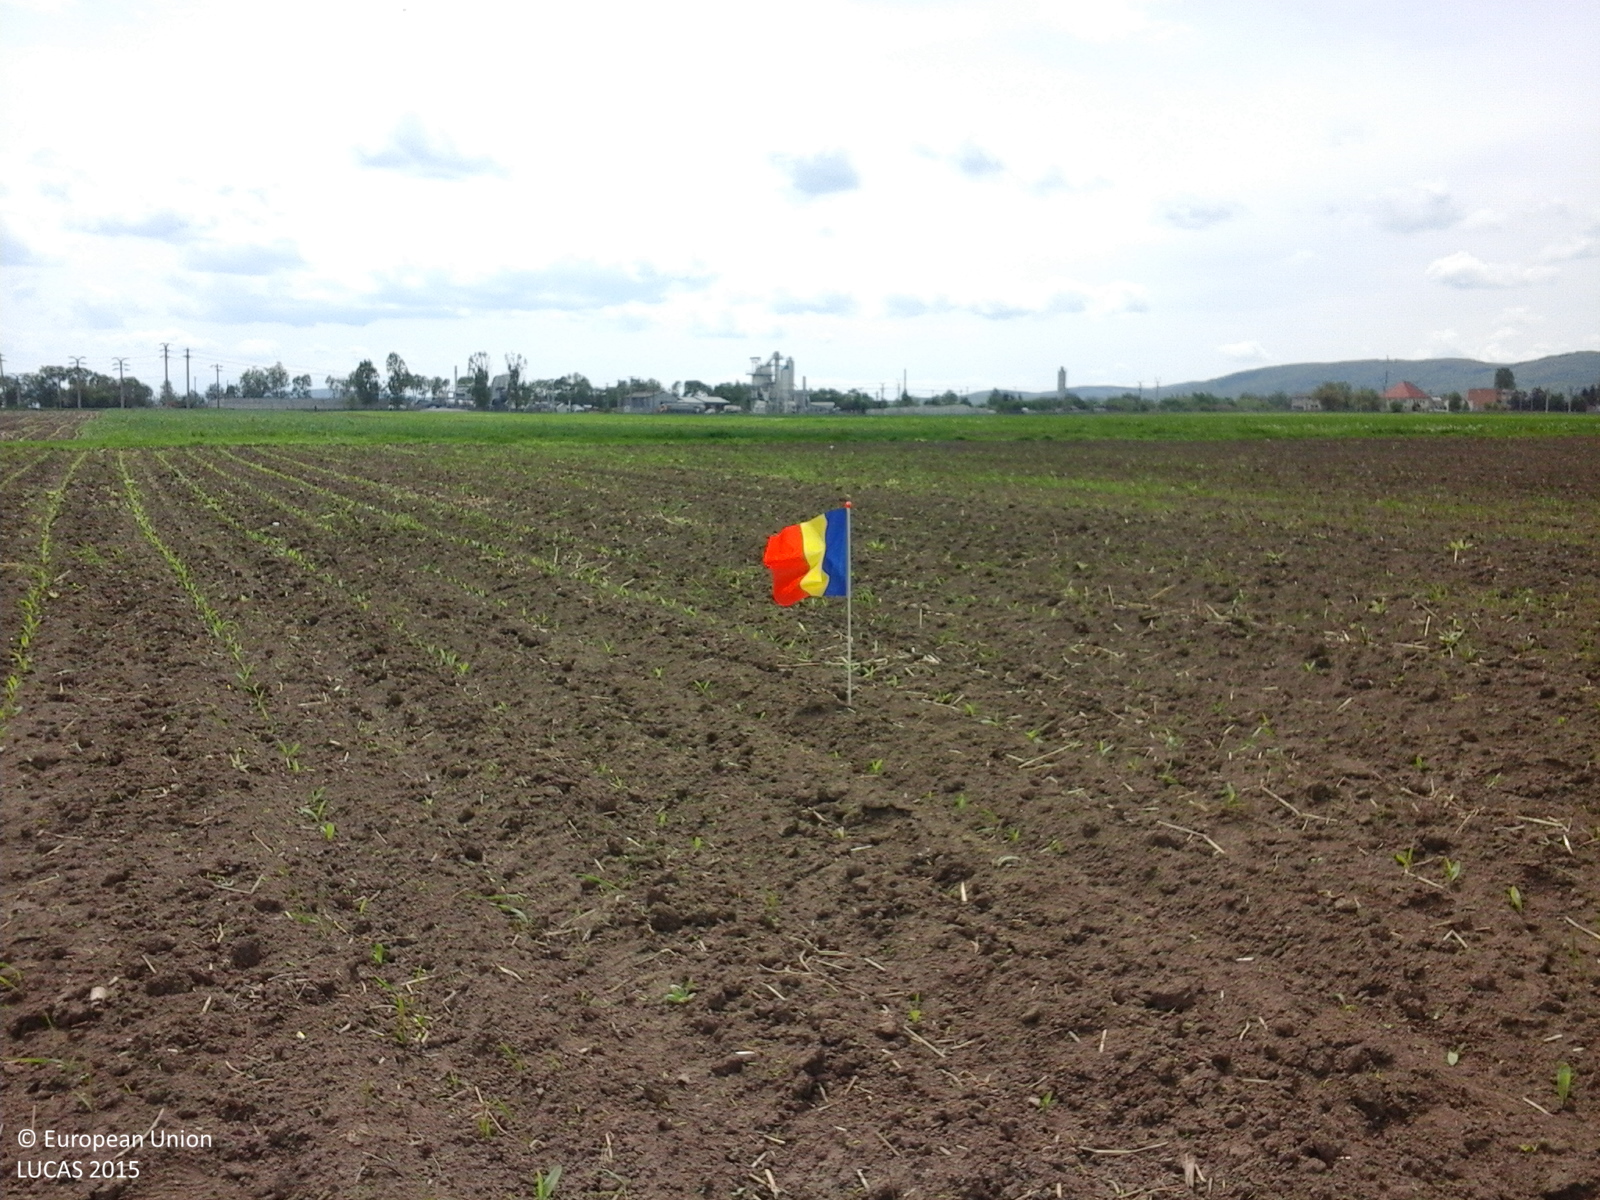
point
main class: Cropland
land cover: Maize
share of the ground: < 10 %
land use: Agriculture (excluding fallow land and kitchen gardens)
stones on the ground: < 10 %
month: May
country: RO
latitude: 45.9190
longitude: 25.8031
